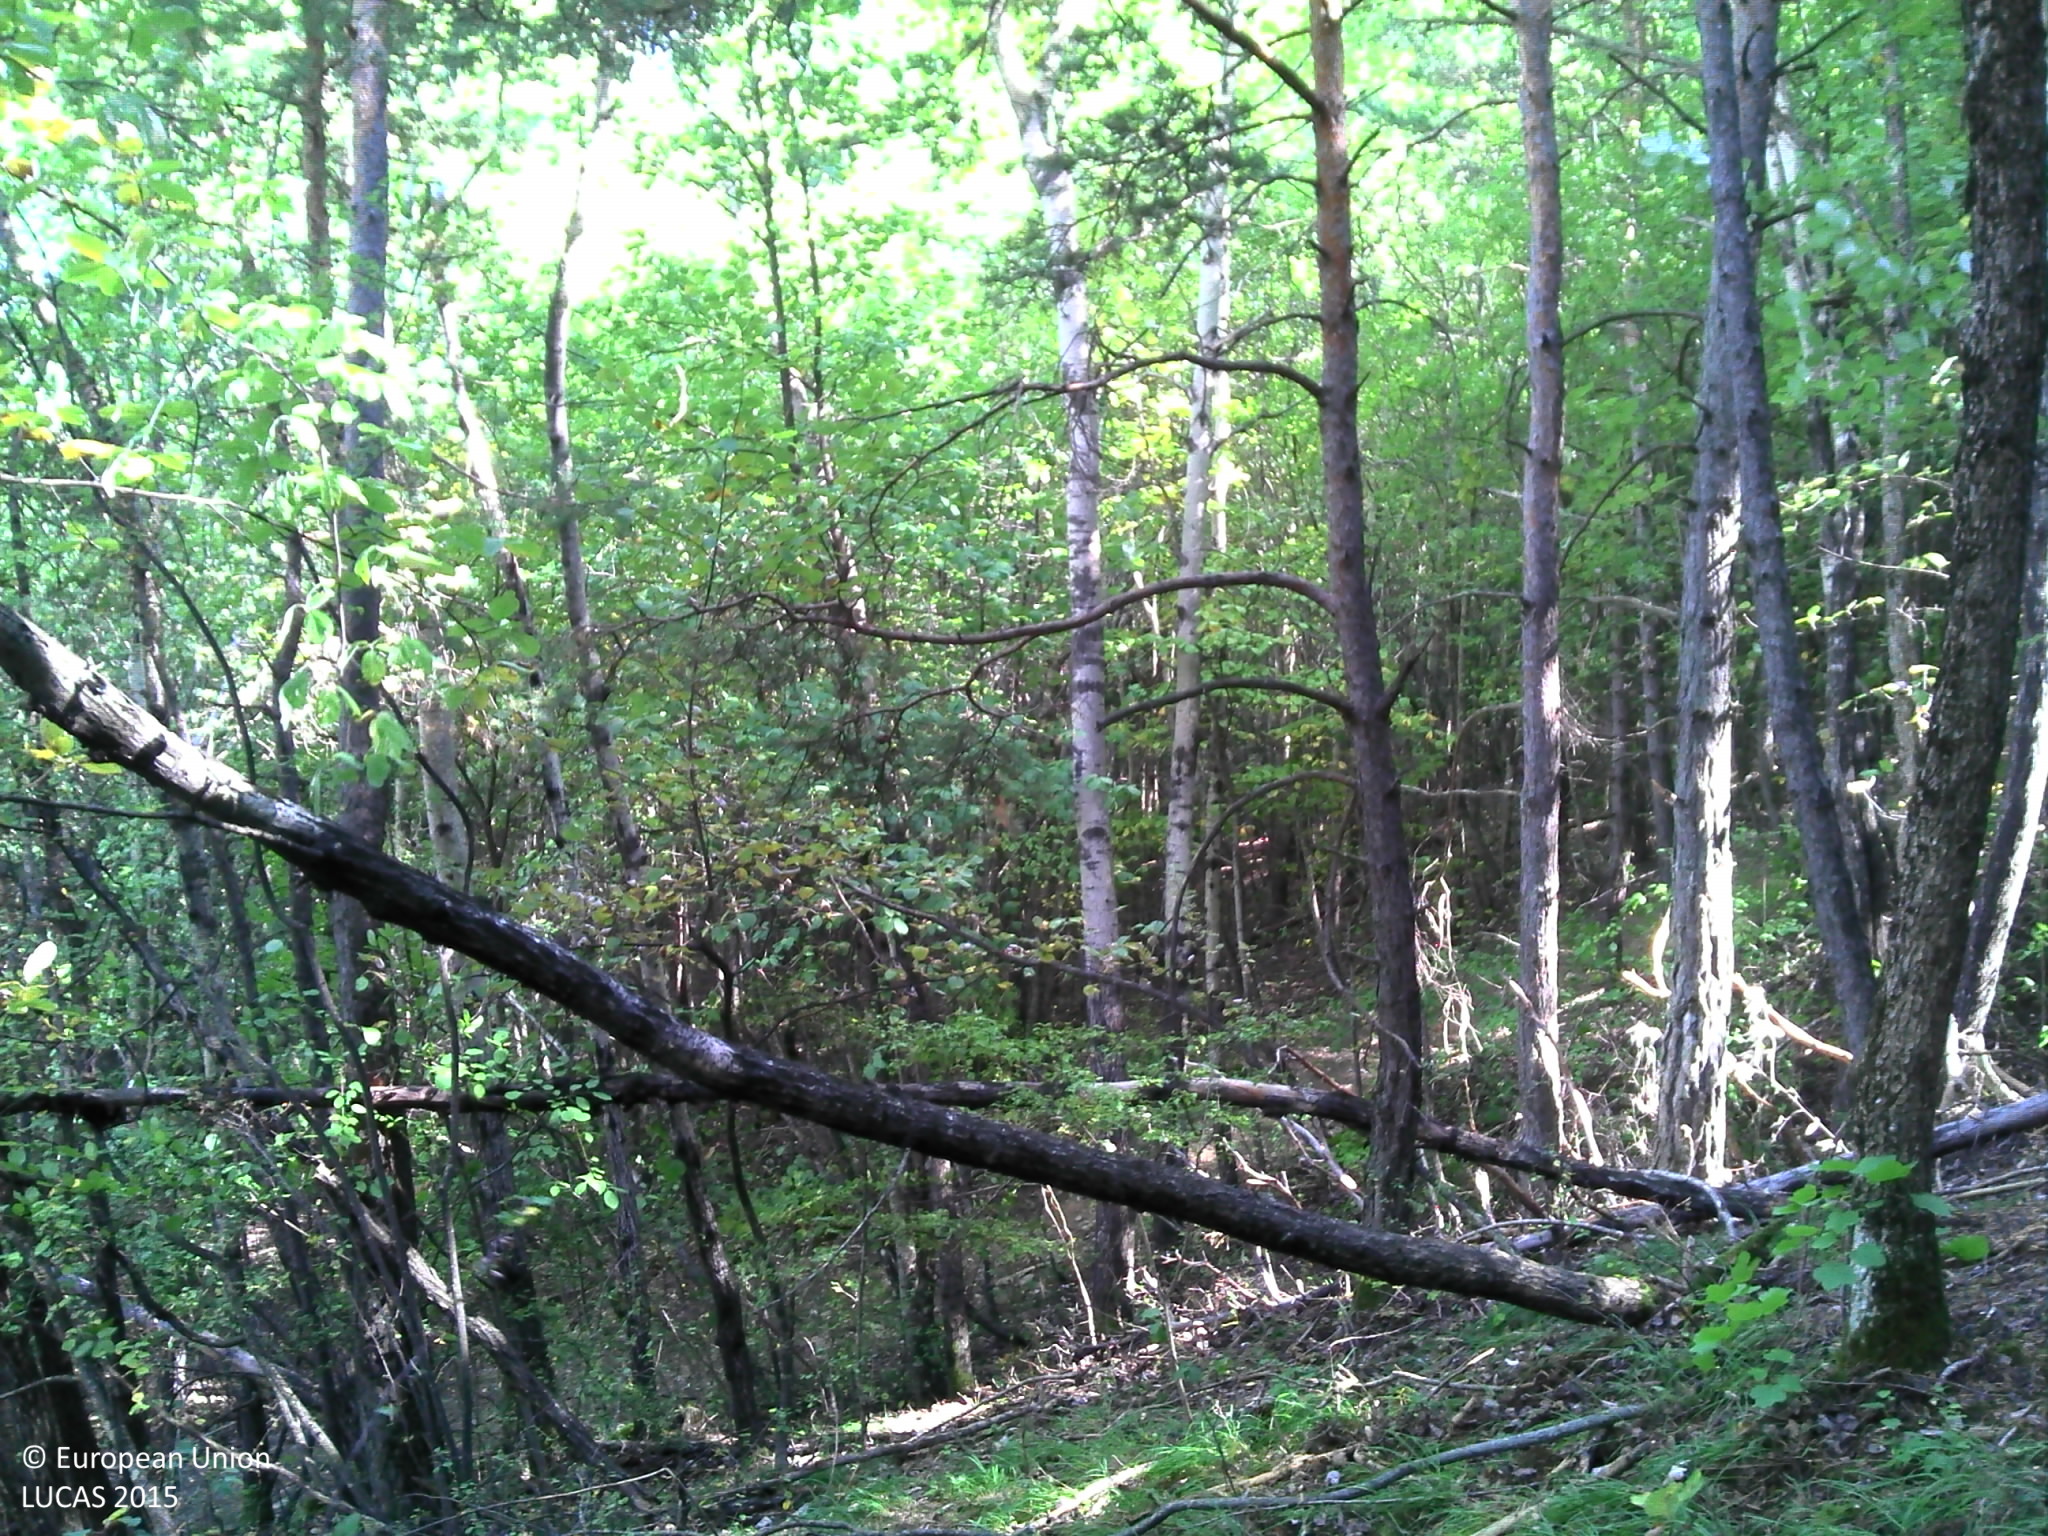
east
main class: Woodland
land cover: Pine dominated mixed woodland
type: hemiboreal forest and nemoral coniferous forest and mixed broadleaved-coniferous forest
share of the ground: > 75 %
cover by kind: coniferous forest trees 60 %, broadleaved forest trees 30 %, herbaceous plants 5 %, unconsolidated bare surface 5 %
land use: Forestry
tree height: > 5 m
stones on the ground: < 10 %
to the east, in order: Pine dominated mixed woodland; Tracks; Pine dominated mixed woodland; Rivers and streams; Pine dominated mixed woodland; Rivers and streams; Pine dominated mixed woodland; Rocks and stones; Shrubland with sparse tree cover
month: September
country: FR
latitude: 44.5235
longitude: 6.4205
